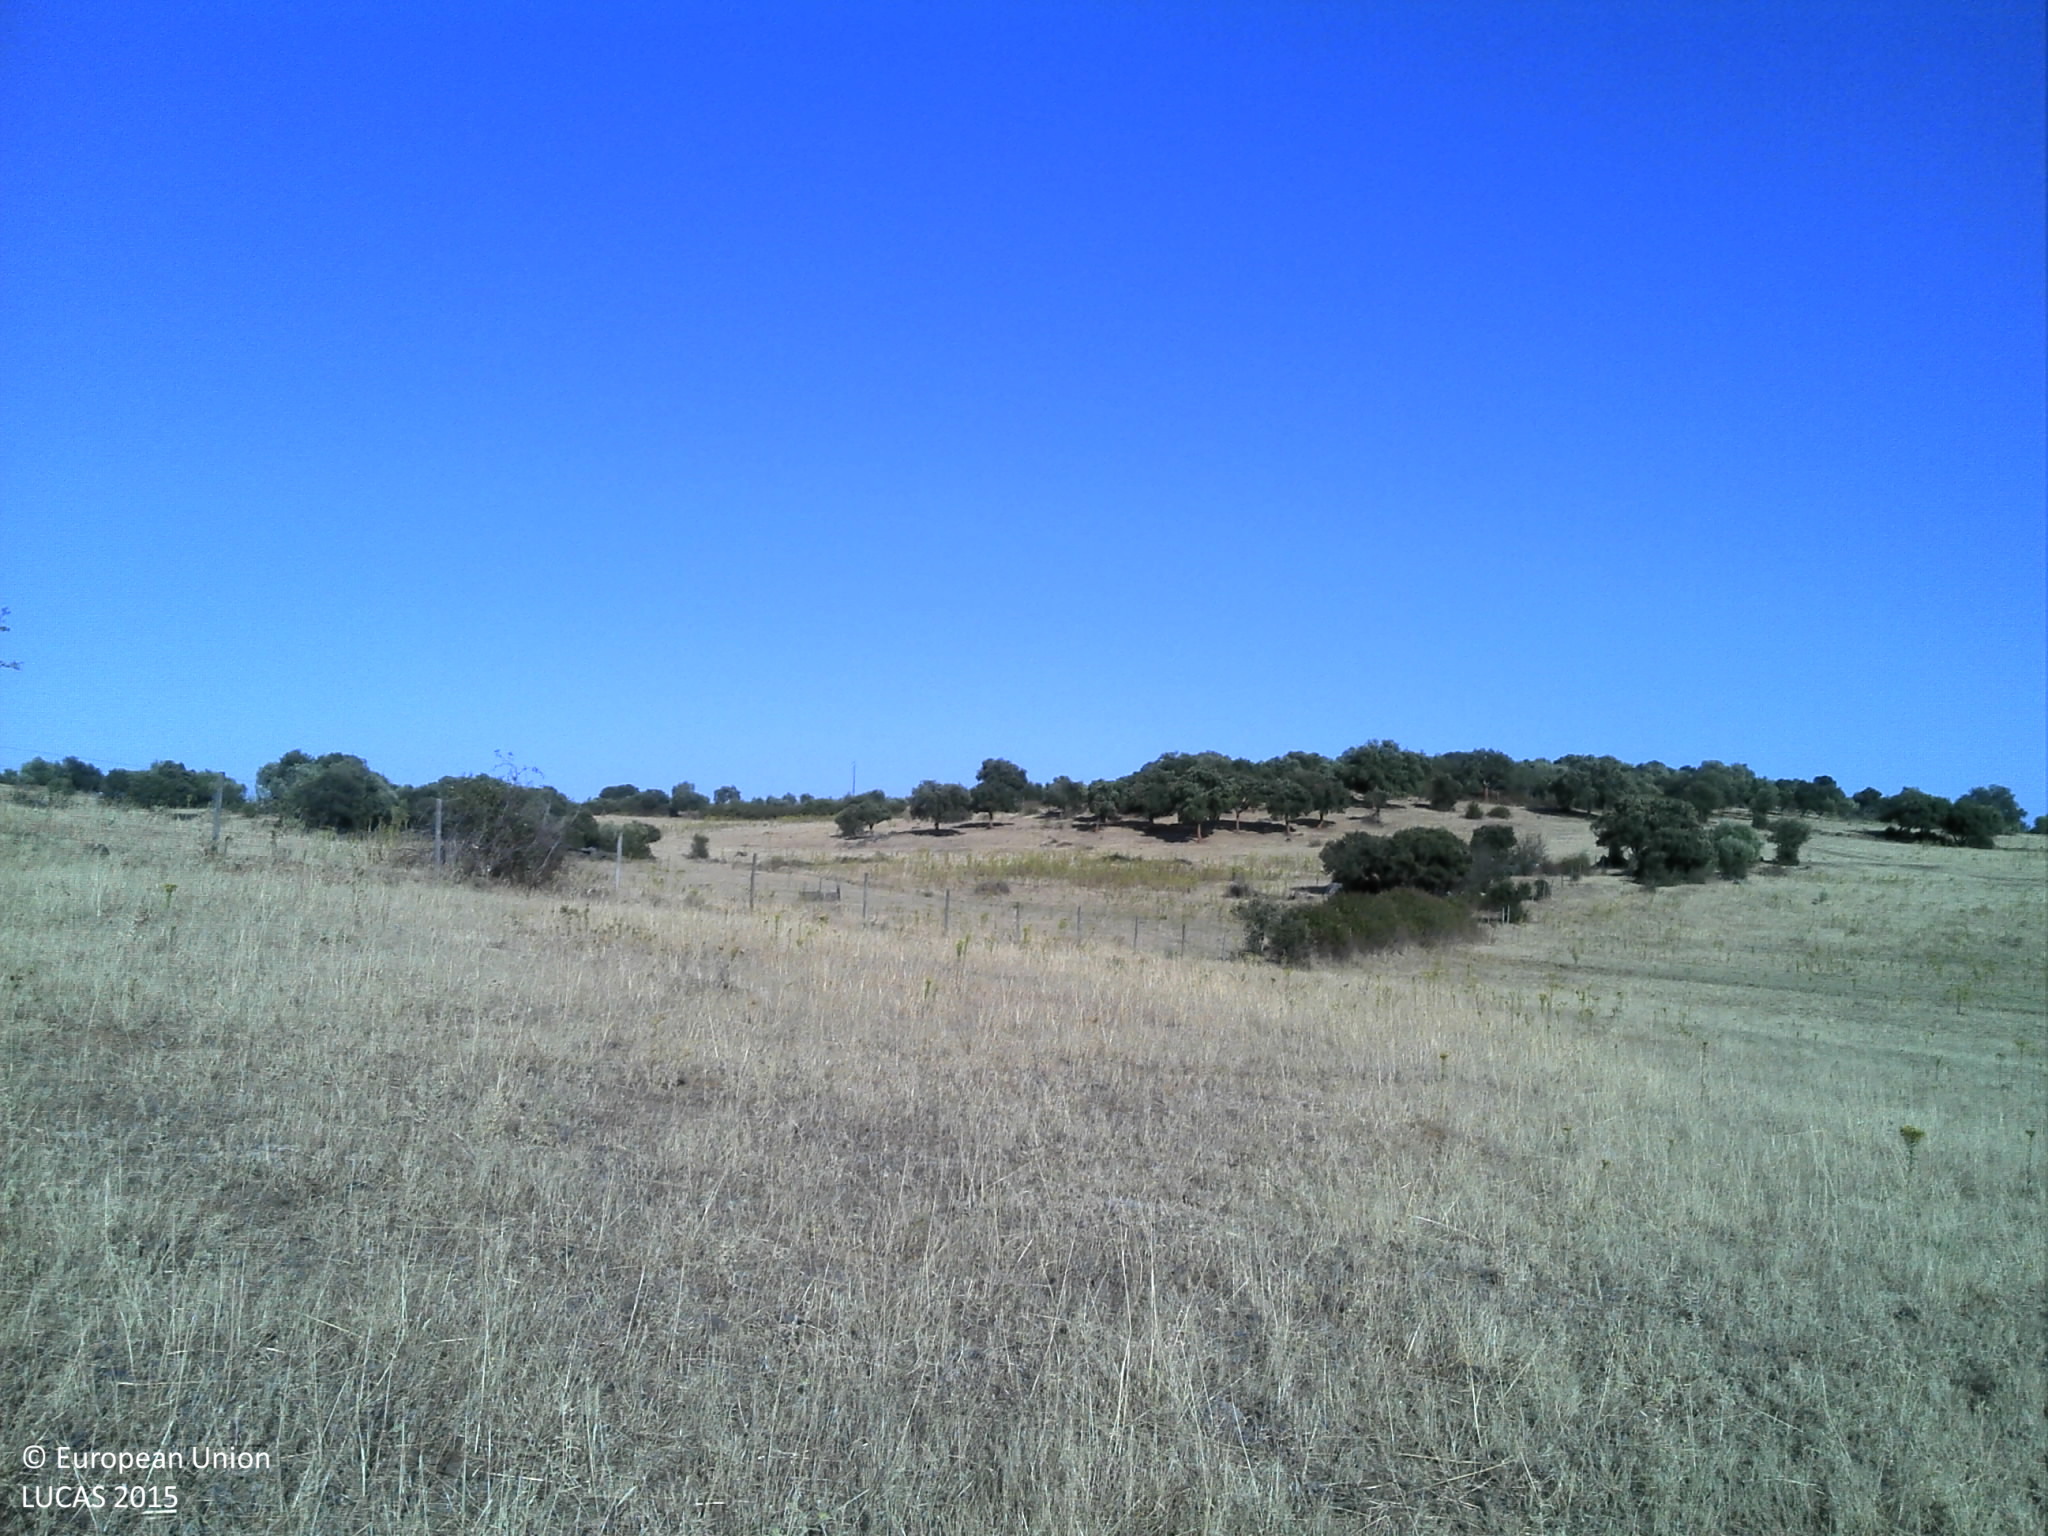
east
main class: Grassland
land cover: Grassland without tree/shrub cover
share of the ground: 25 - 50 %
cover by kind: unconsolidated bare surface 75 %, herbaceous plants 25 %
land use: Agriculture (excluding fallow land and kitchen gardens)
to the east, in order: Grassland without tree/shrub cover; Fences; Broadleaved woodland; Grassland without tree/shrub cover; Grassland with sparse tree/shrub cover; Grassland without tree/shrub cover; Broadleaved woodland; Grassland without tree/shrub cover; Olive groves
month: July
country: PT
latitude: 38.9716
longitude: -7.5241
